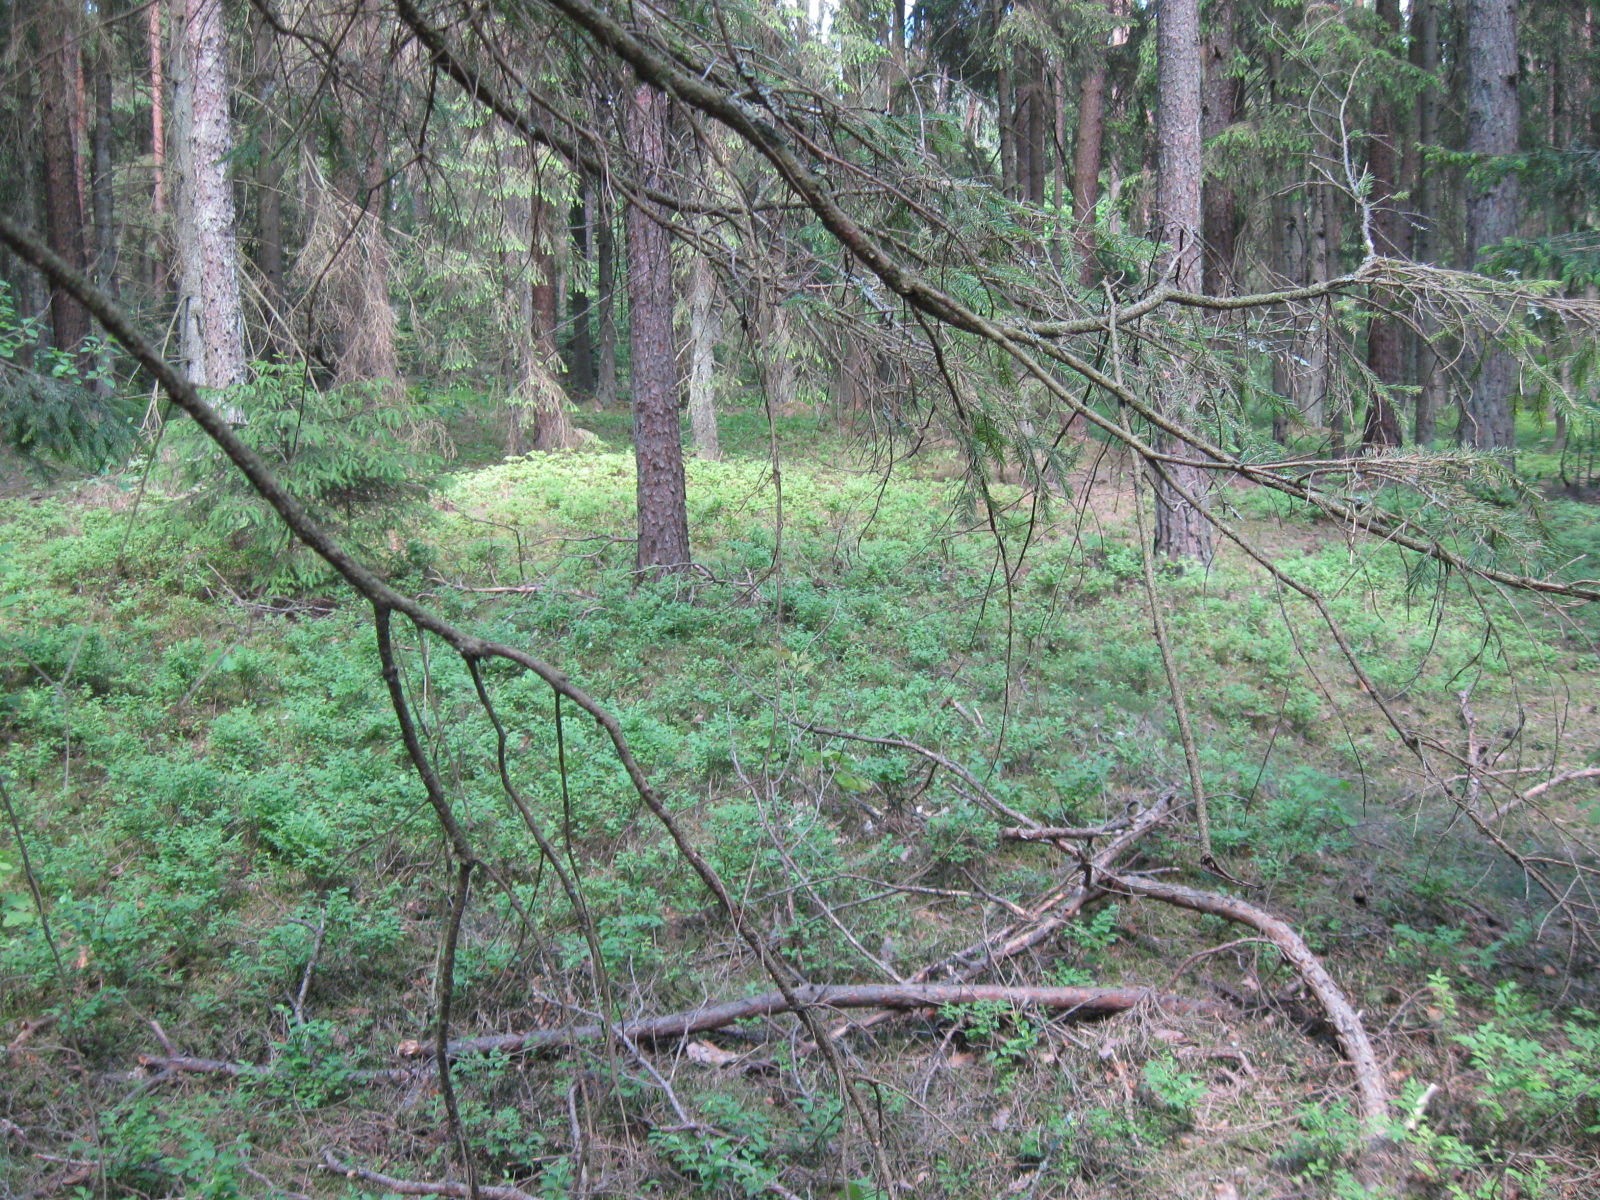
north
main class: Woodland
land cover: Other coniferous woodland
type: hemiboreal forest and nemoral coniferous forest and mixed broadleaved-coniferous forest
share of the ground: > 75 %
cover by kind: coniferous forest trees 90 %, herbaceous plants 10 %
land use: Forestry
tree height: > 5 m
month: June
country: LT
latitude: 54.6161
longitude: 23.7920
